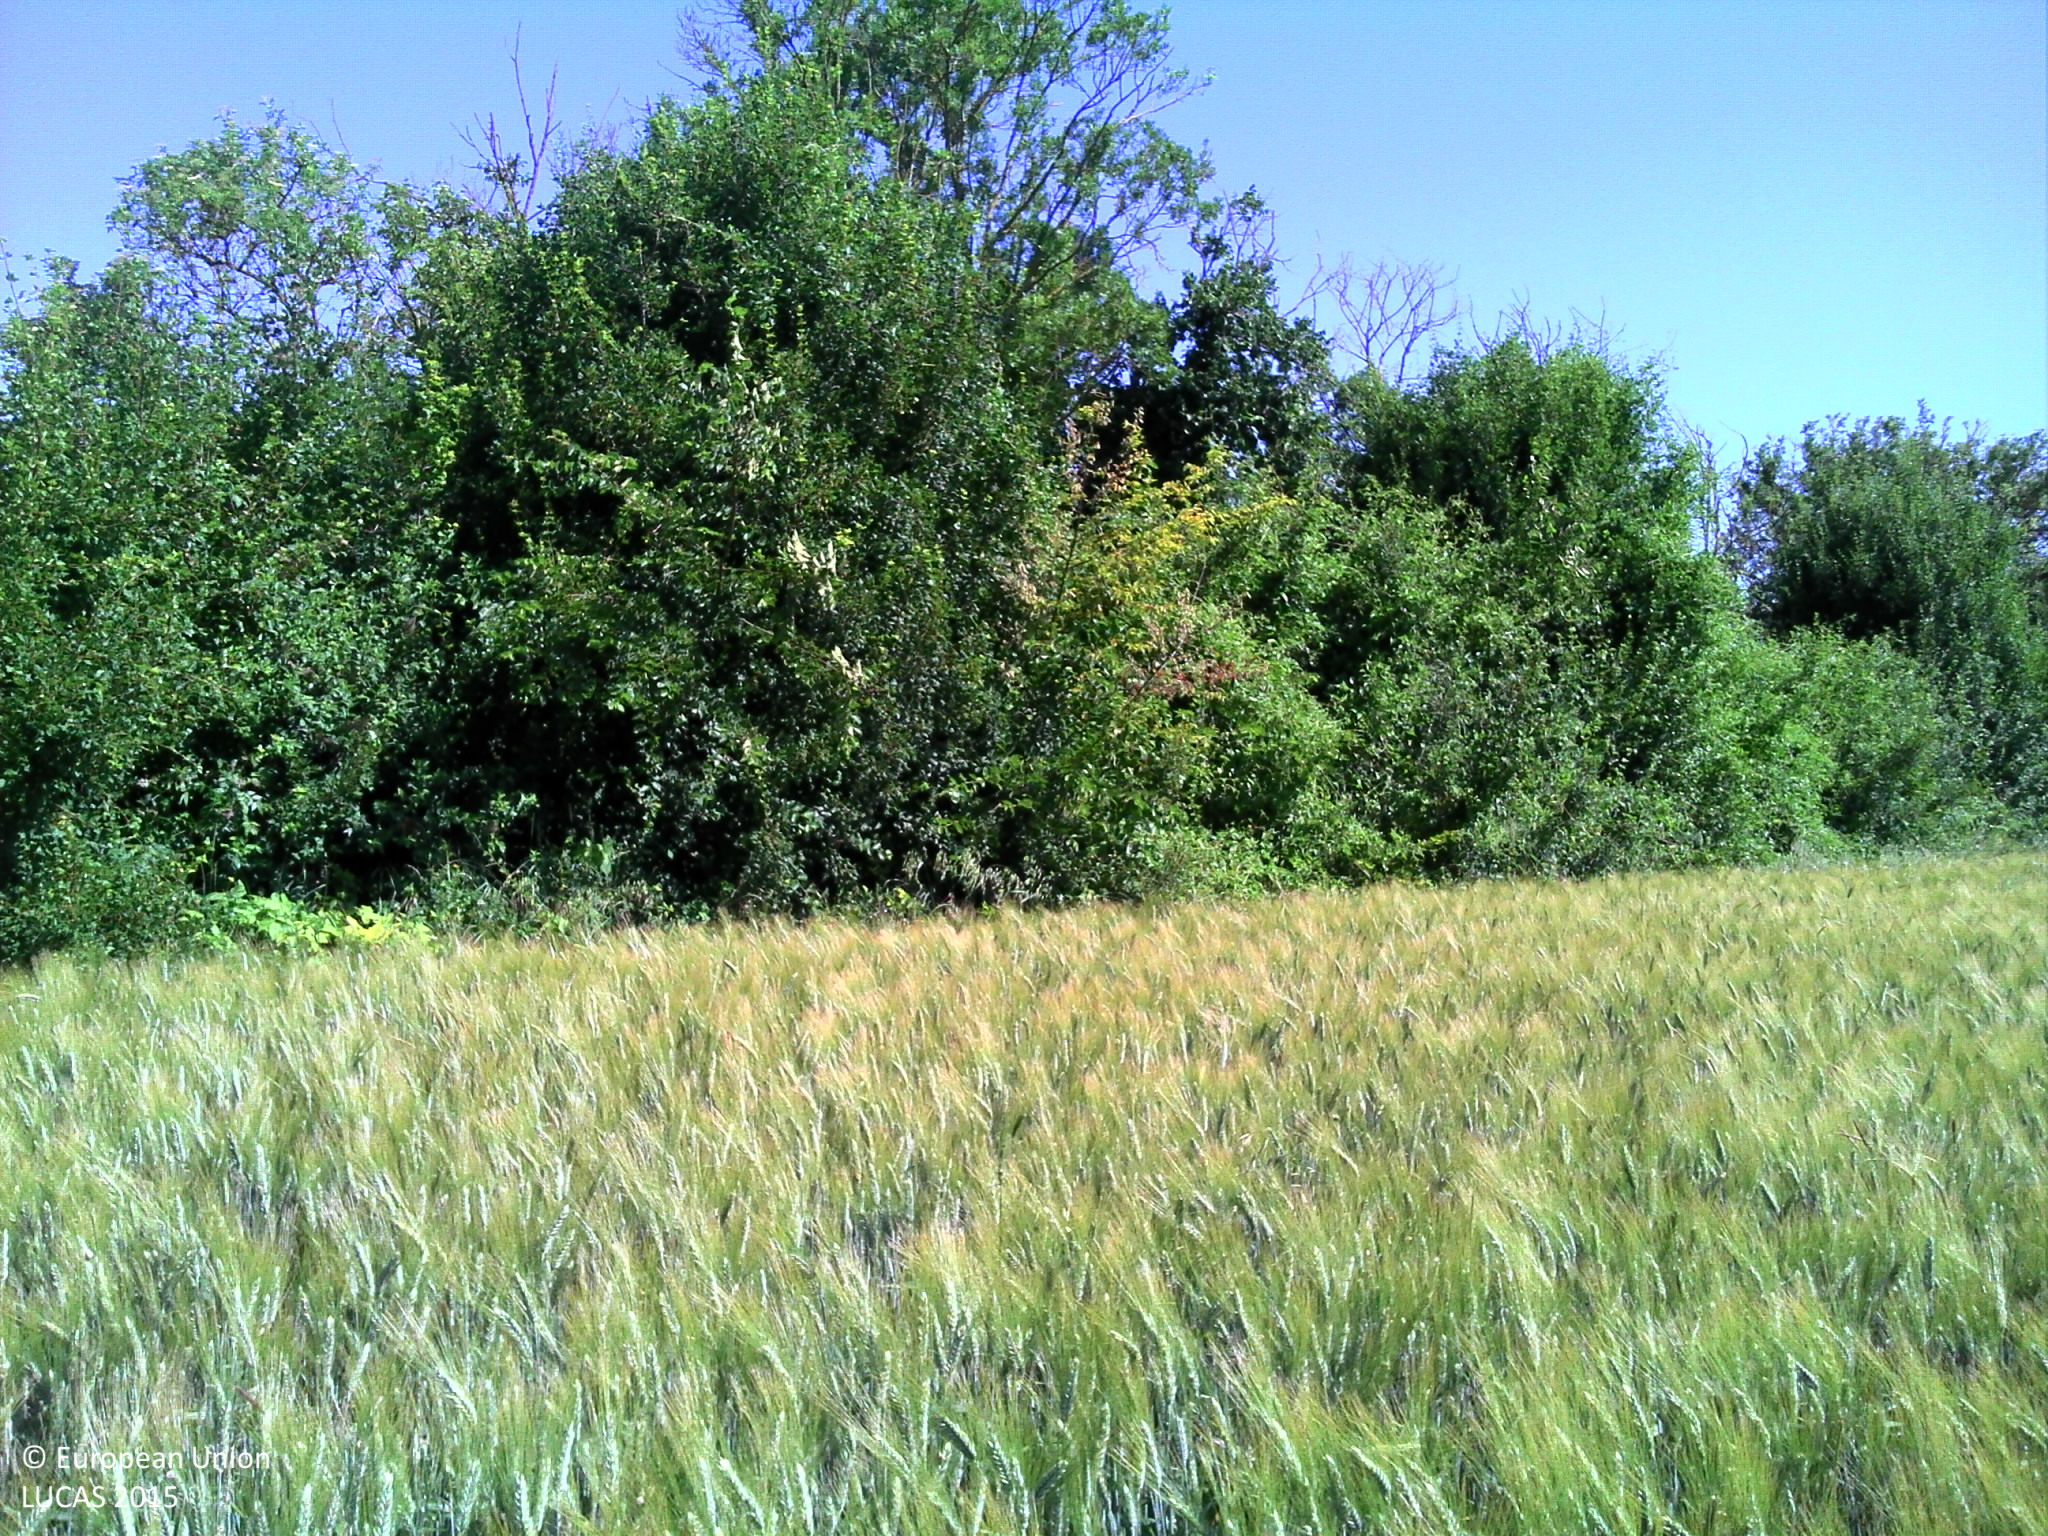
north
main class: Cropland
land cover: Durum wheat
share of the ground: > 75 %
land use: Agriculture (excluding fallow land and kitchen gardens)
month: June
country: FR
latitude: 46.1762
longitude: -1.0544
